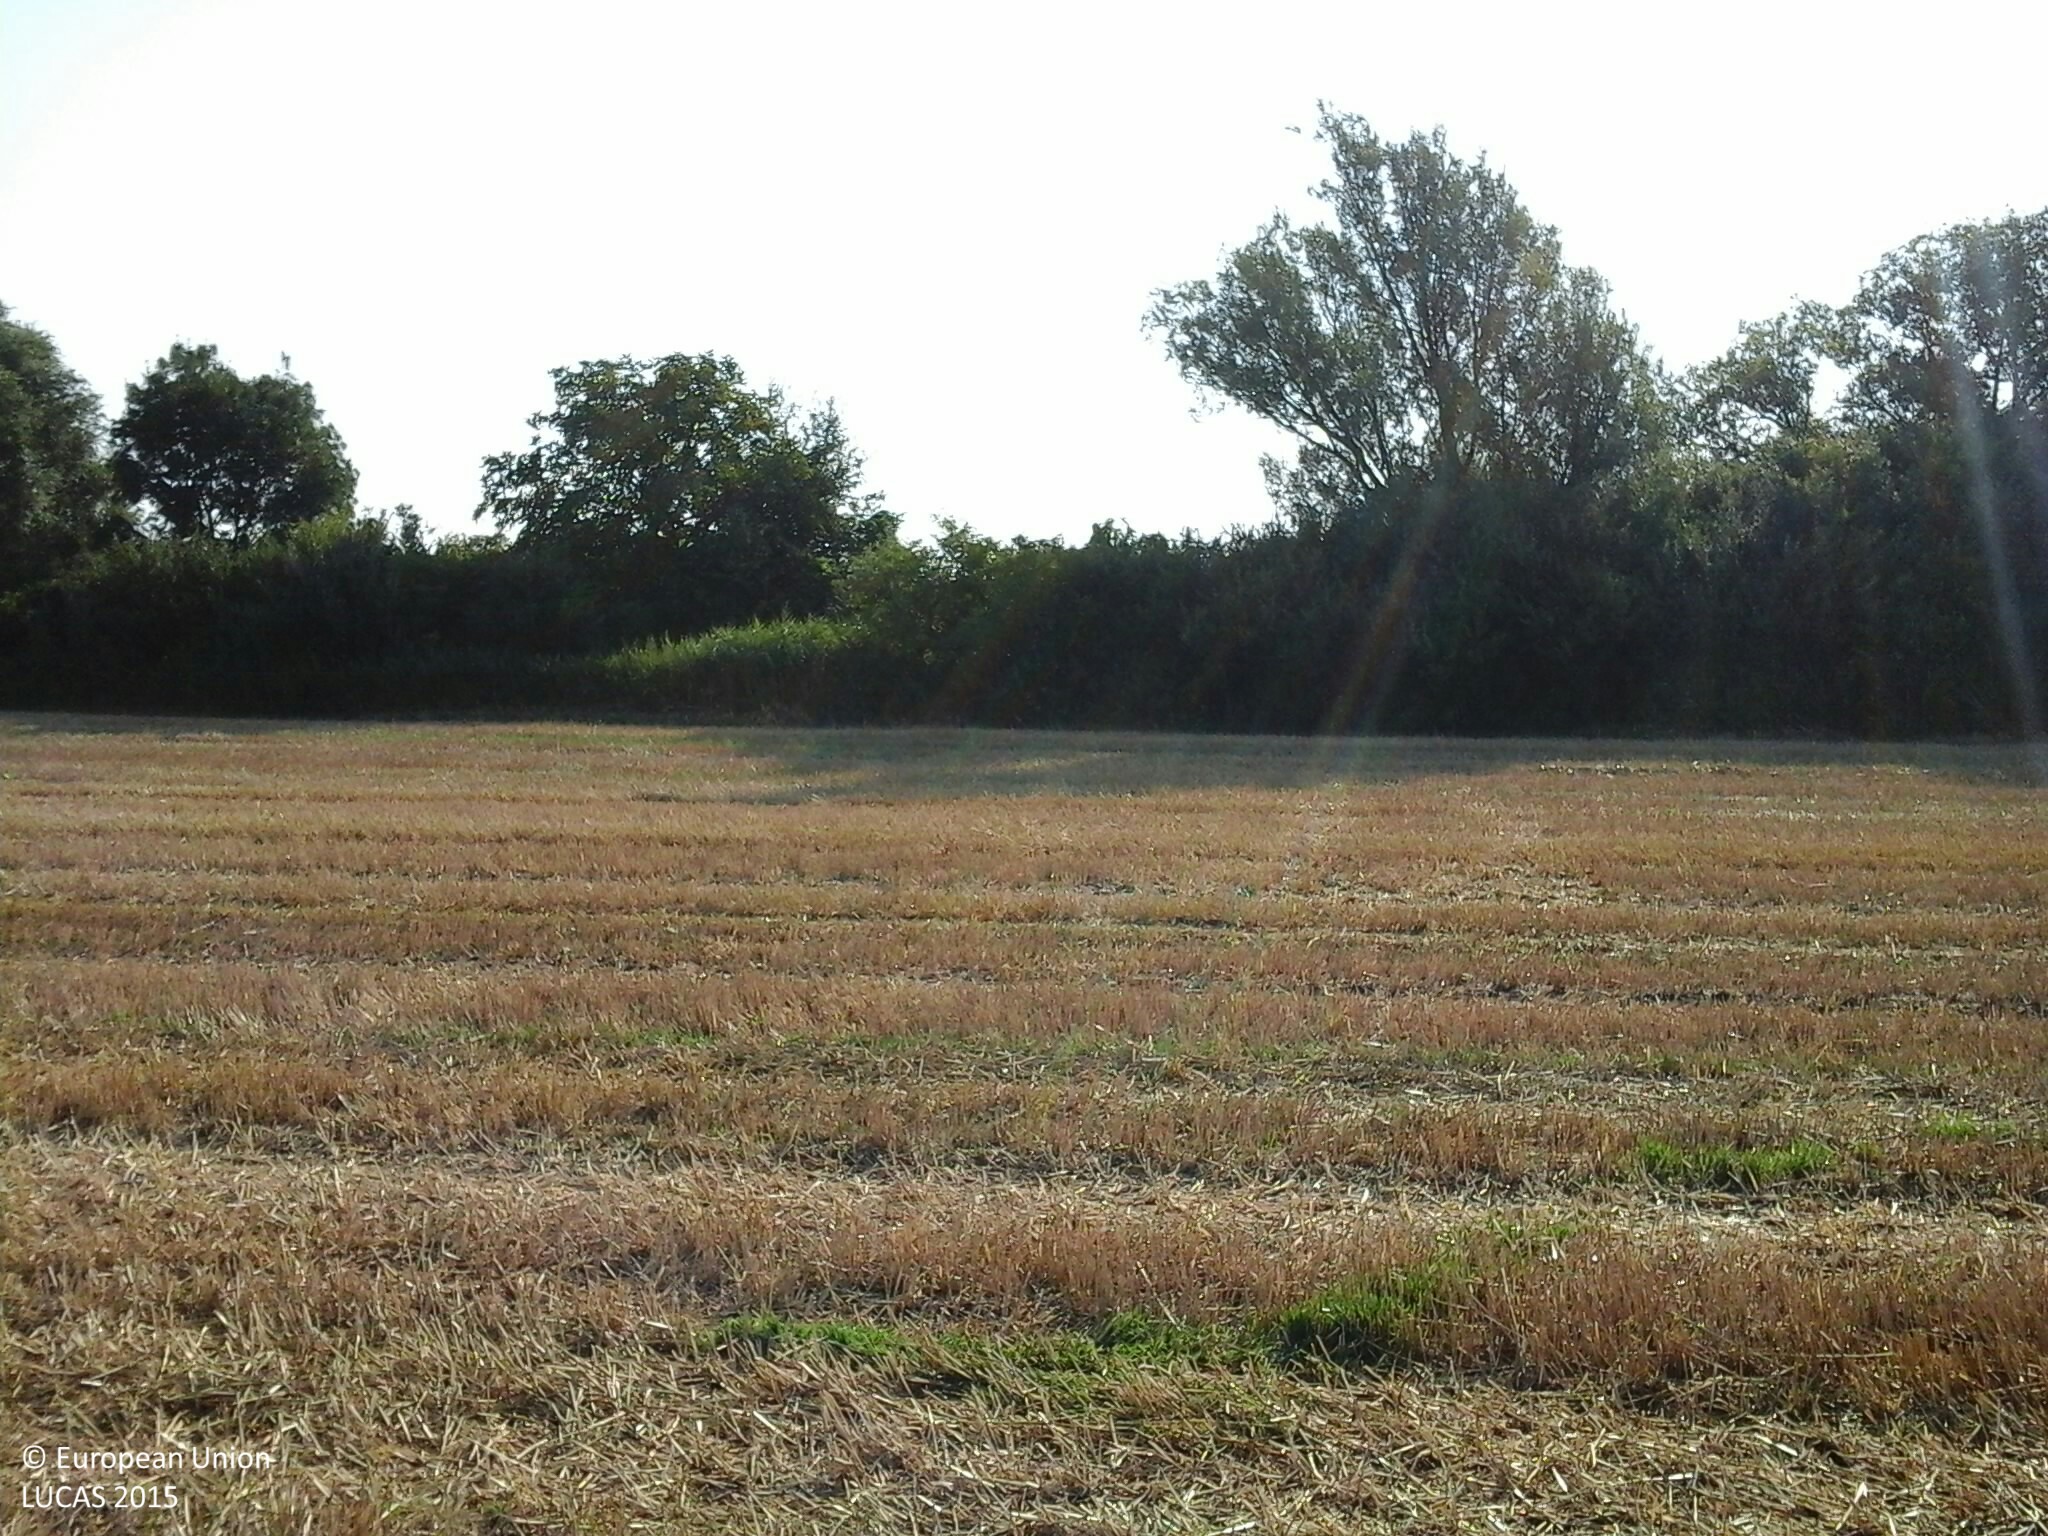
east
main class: Cropland
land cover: Common wheat
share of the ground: 25 - 50 %
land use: Agriculture (excluding fallow land and kitchen gardens)
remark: Harvested field
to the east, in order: Common wheat; Abandoned hedges; Rivers and streams; Broadleaved woodland; Common wheat
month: August
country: HU
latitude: 47.2430
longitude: 16.7019
